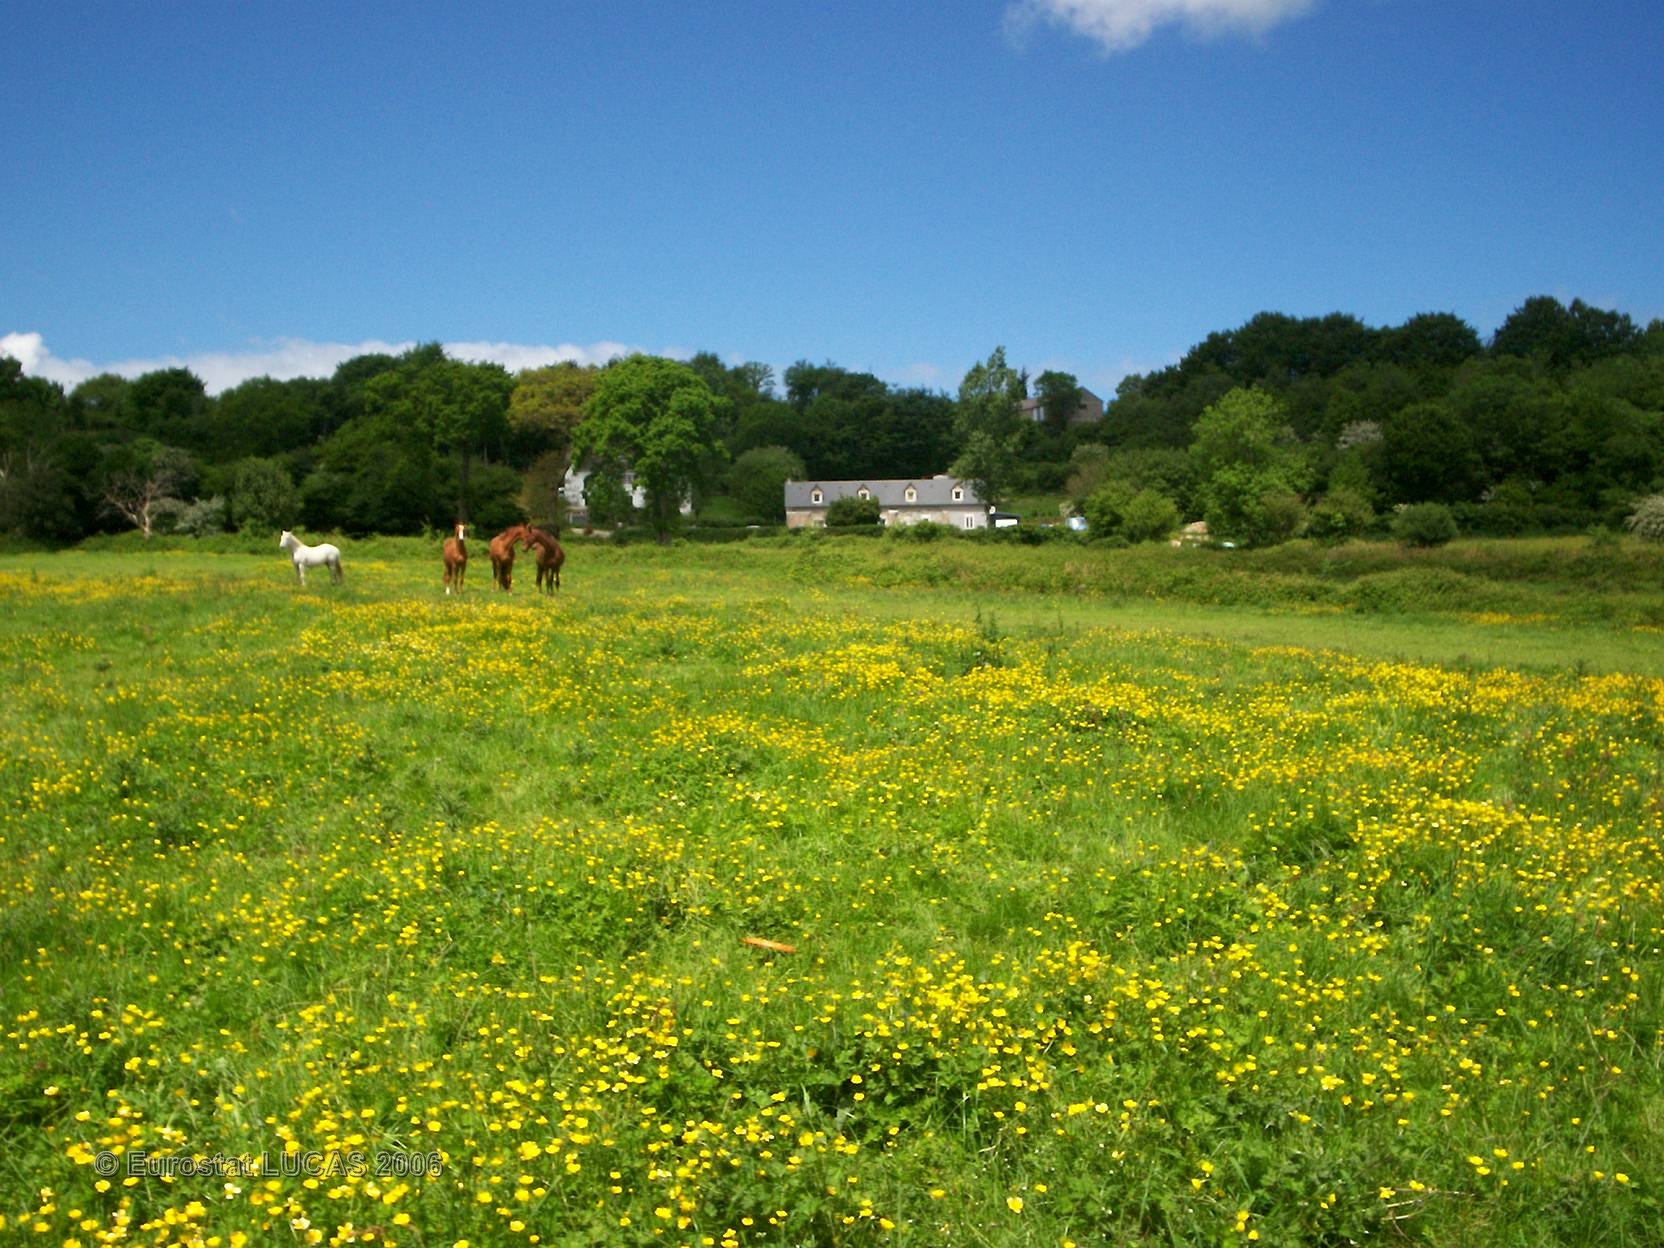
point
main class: Grassland
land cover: Grassland without tree/shrub cover
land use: Agriculture (excluding fallow land and kitchen gardens)
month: May
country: FR
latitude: 49.5868
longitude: -1.6292
